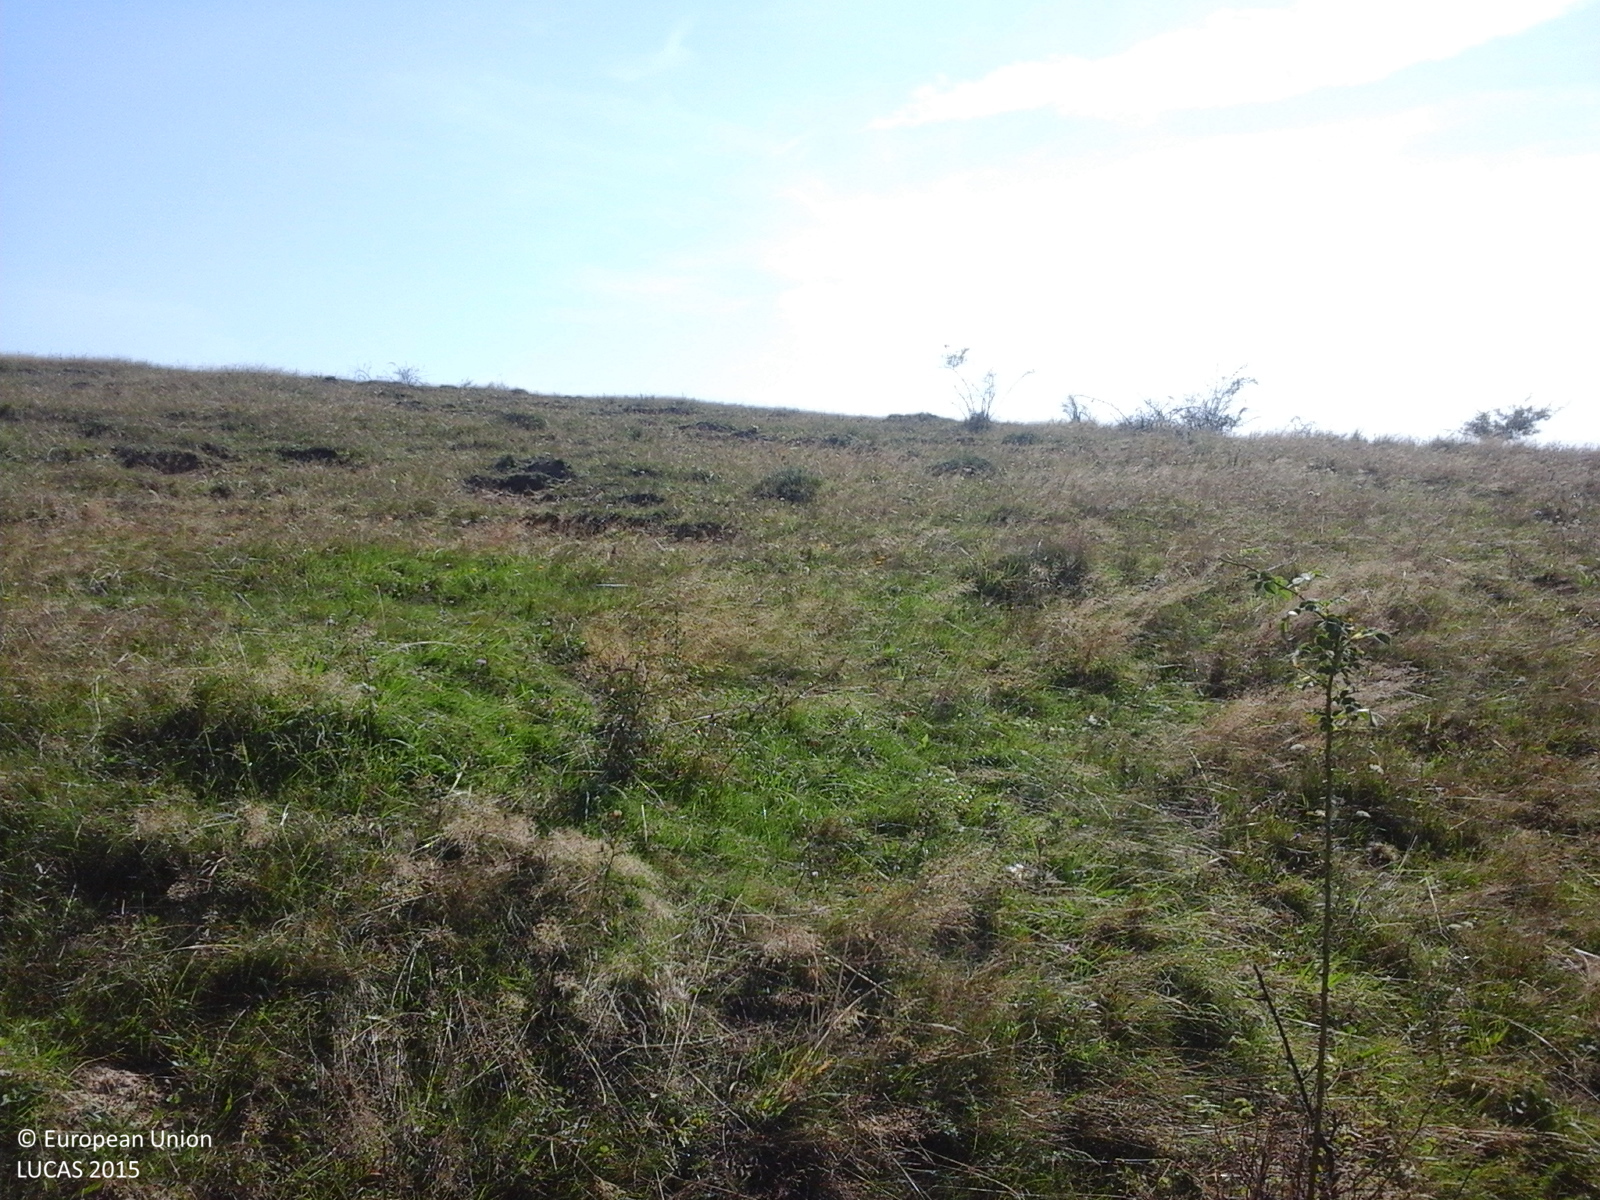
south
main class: Grassland
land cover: Grassland without tree/shrub cover
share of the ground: > 75 %
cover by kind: herbaceous plants 100 %
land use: Agriculture (excluding fallow land and kitchen gardens)
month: September
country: RO
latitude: 46.7142
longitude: 23.6372
